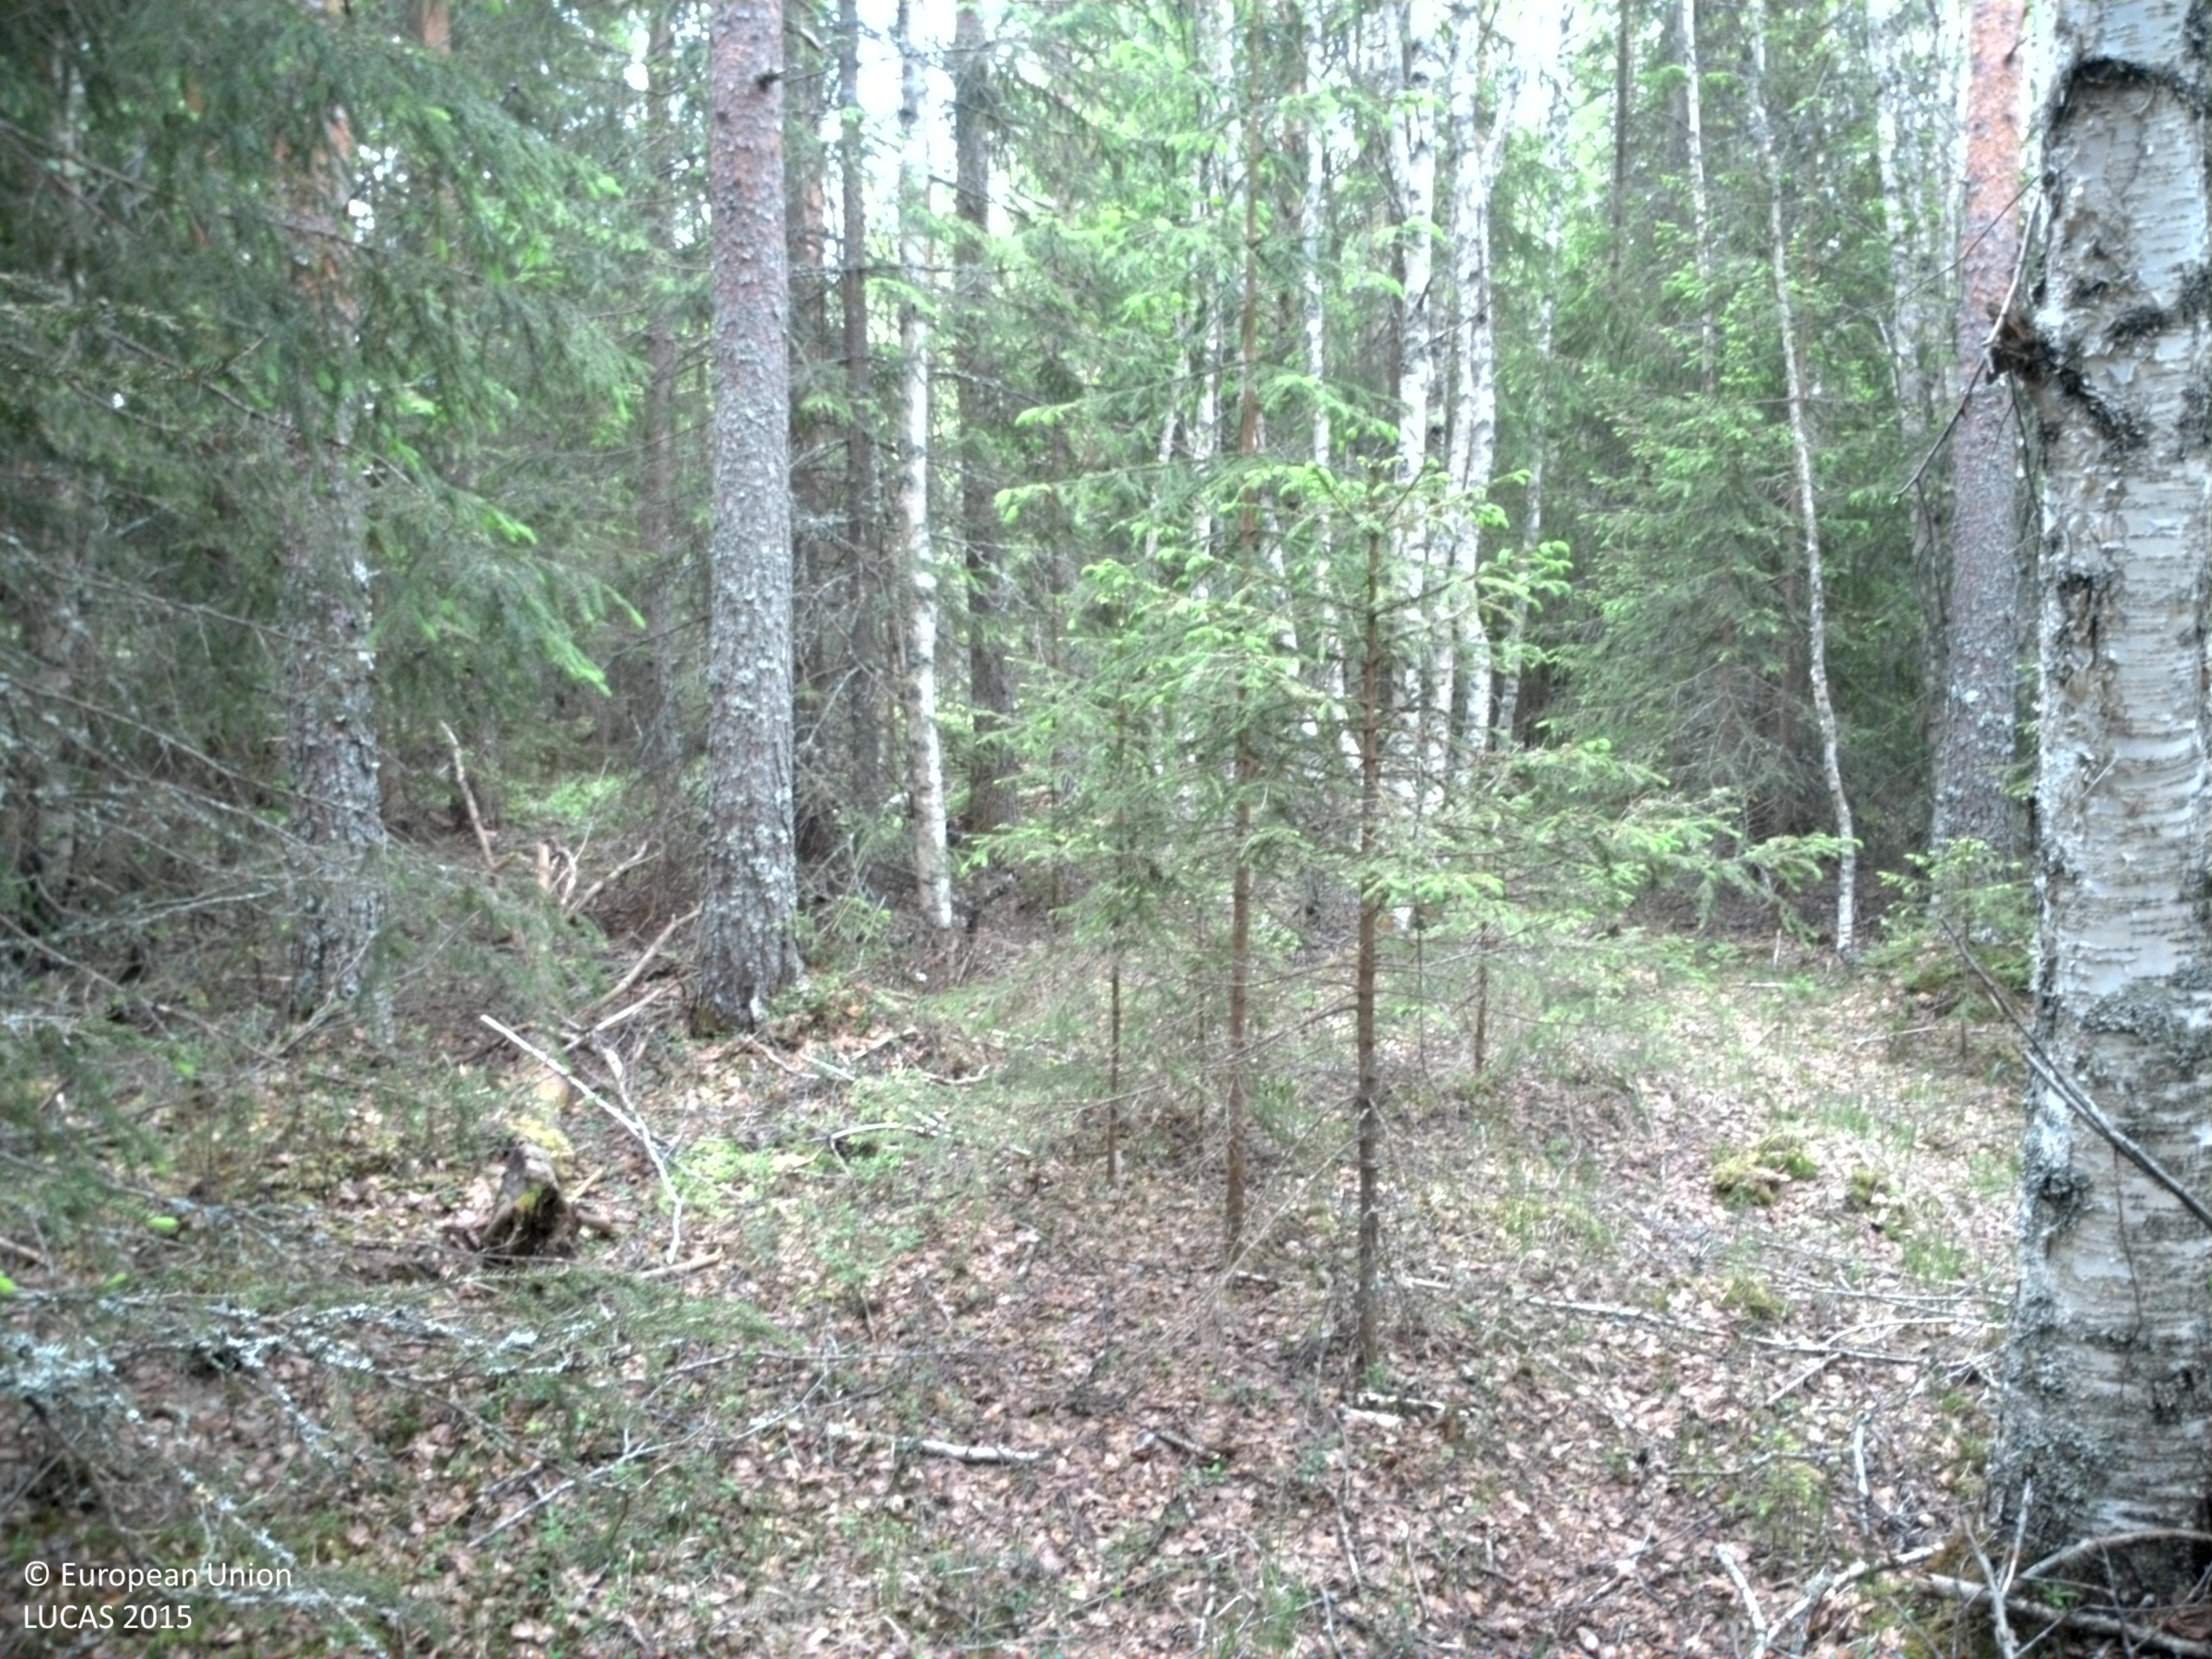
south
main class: Woodland
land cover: Other mixed woodland
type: boreal forest
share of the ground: > 75 %
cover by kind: coniferous forest trees 40 %, broadleaved forest trees 40 %, herbaceous plants 10 %, lichens and mosses 10 %
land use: Forestry
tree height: > 5 m
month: June
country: SE
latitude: 61.1448
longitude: 13.5731
